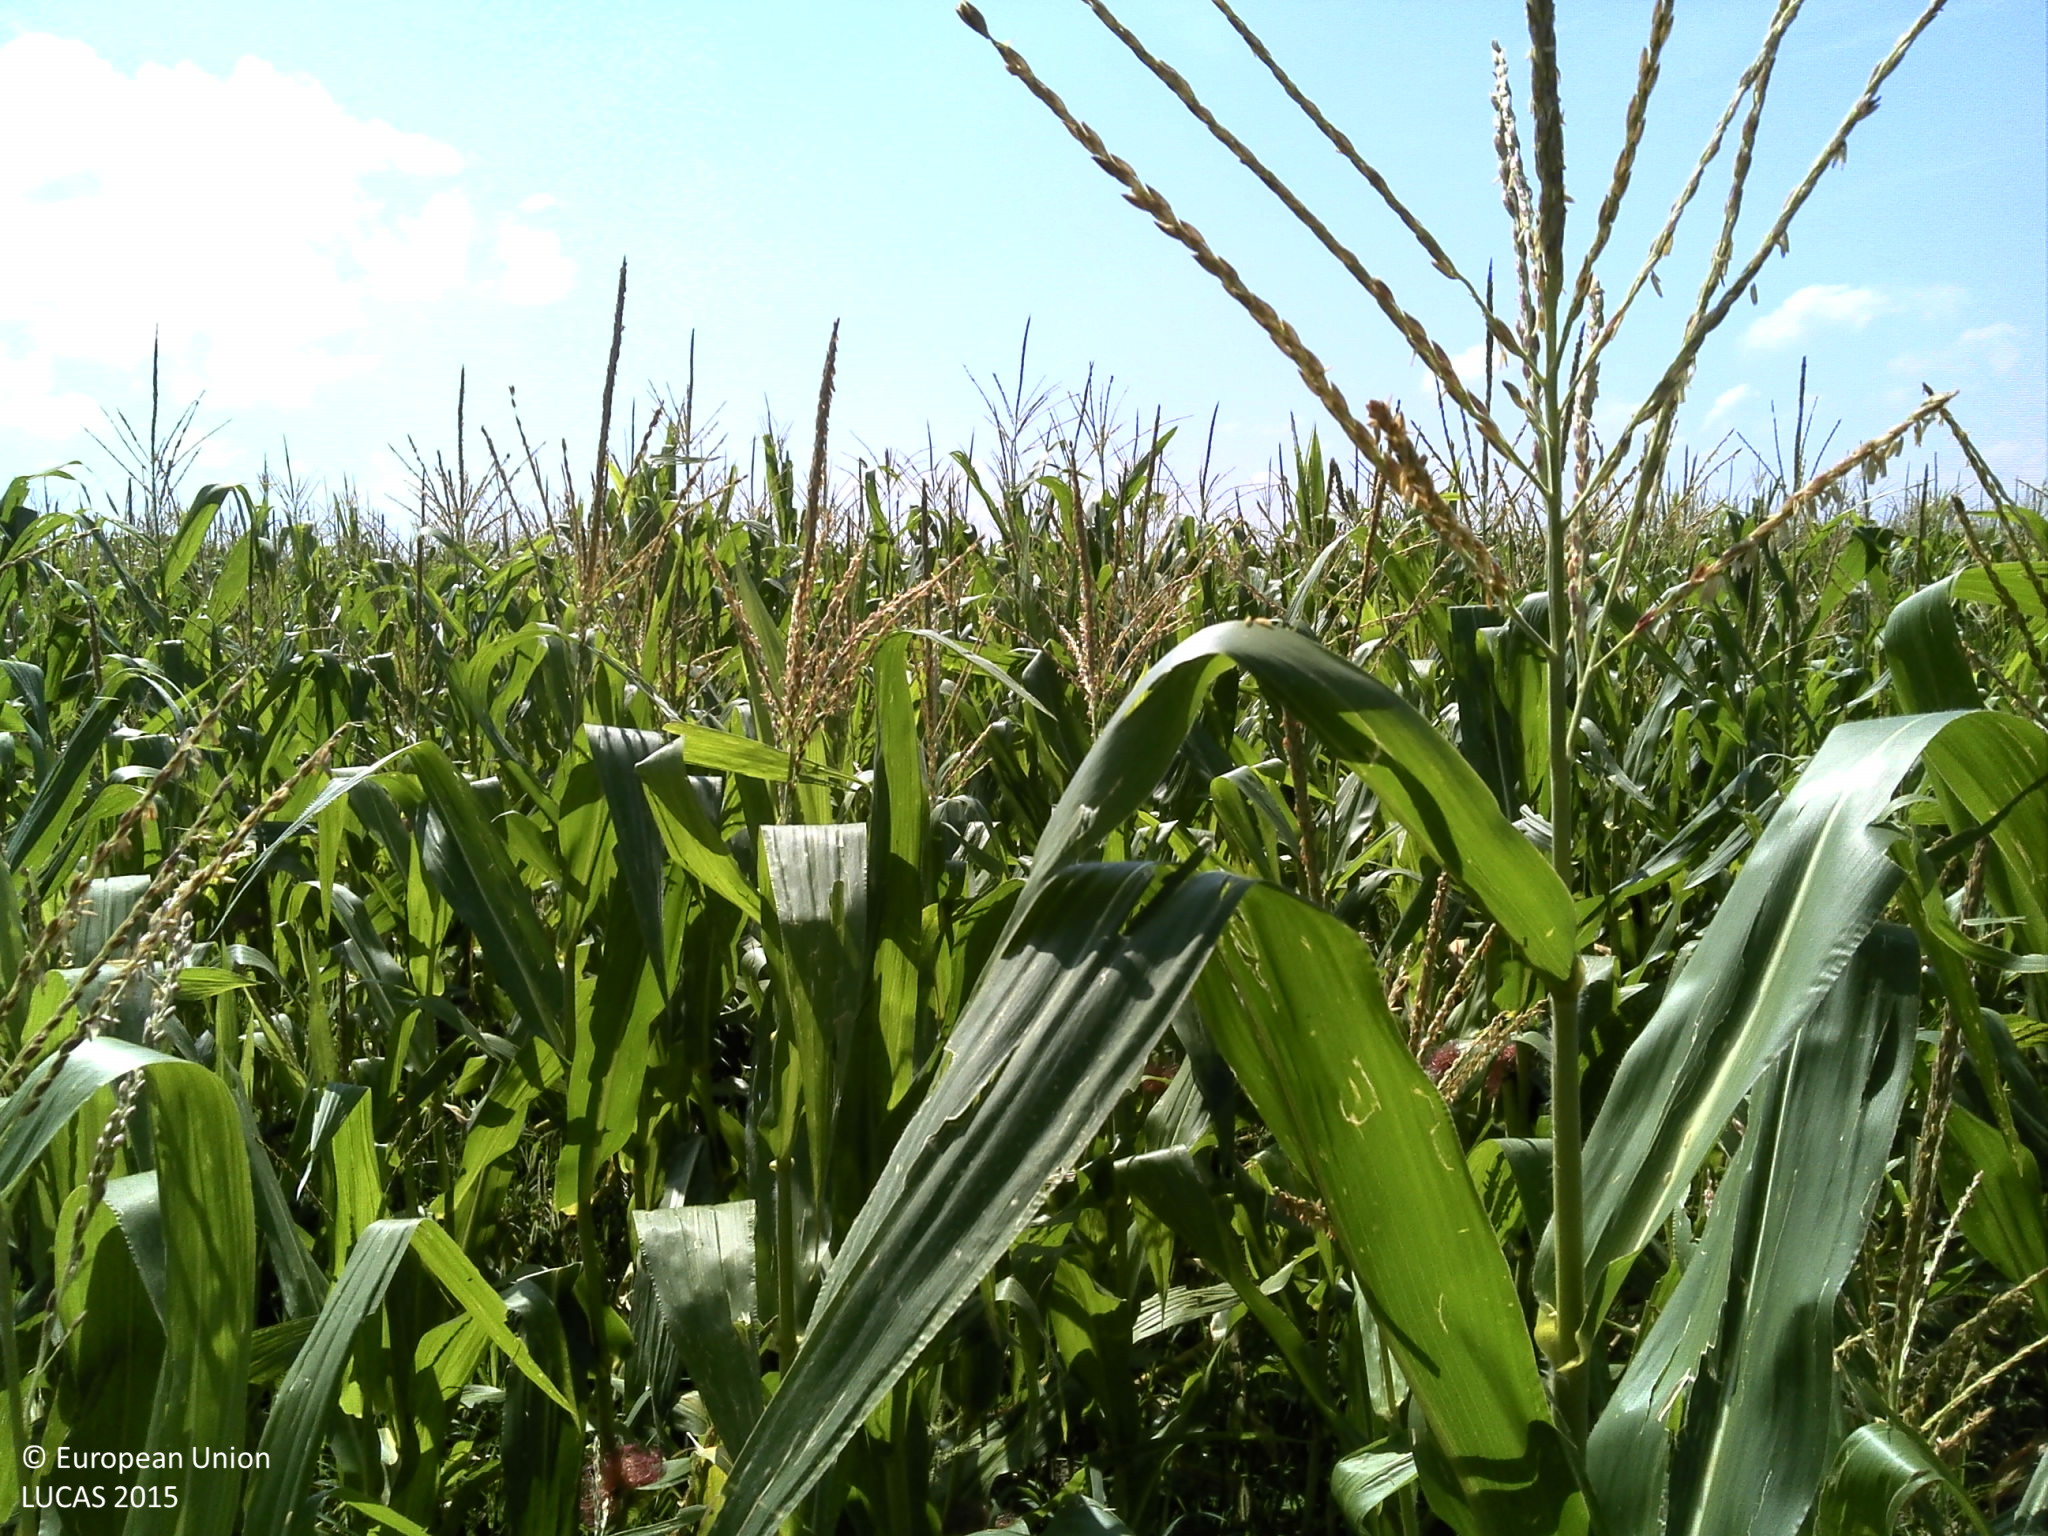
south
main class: Cropland
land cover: Maize
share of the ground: > 75 %
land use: Agriculture (excluding fallow land and kitchen gardens)
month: August
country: HR
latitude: 45.5528
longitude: 16.5699
